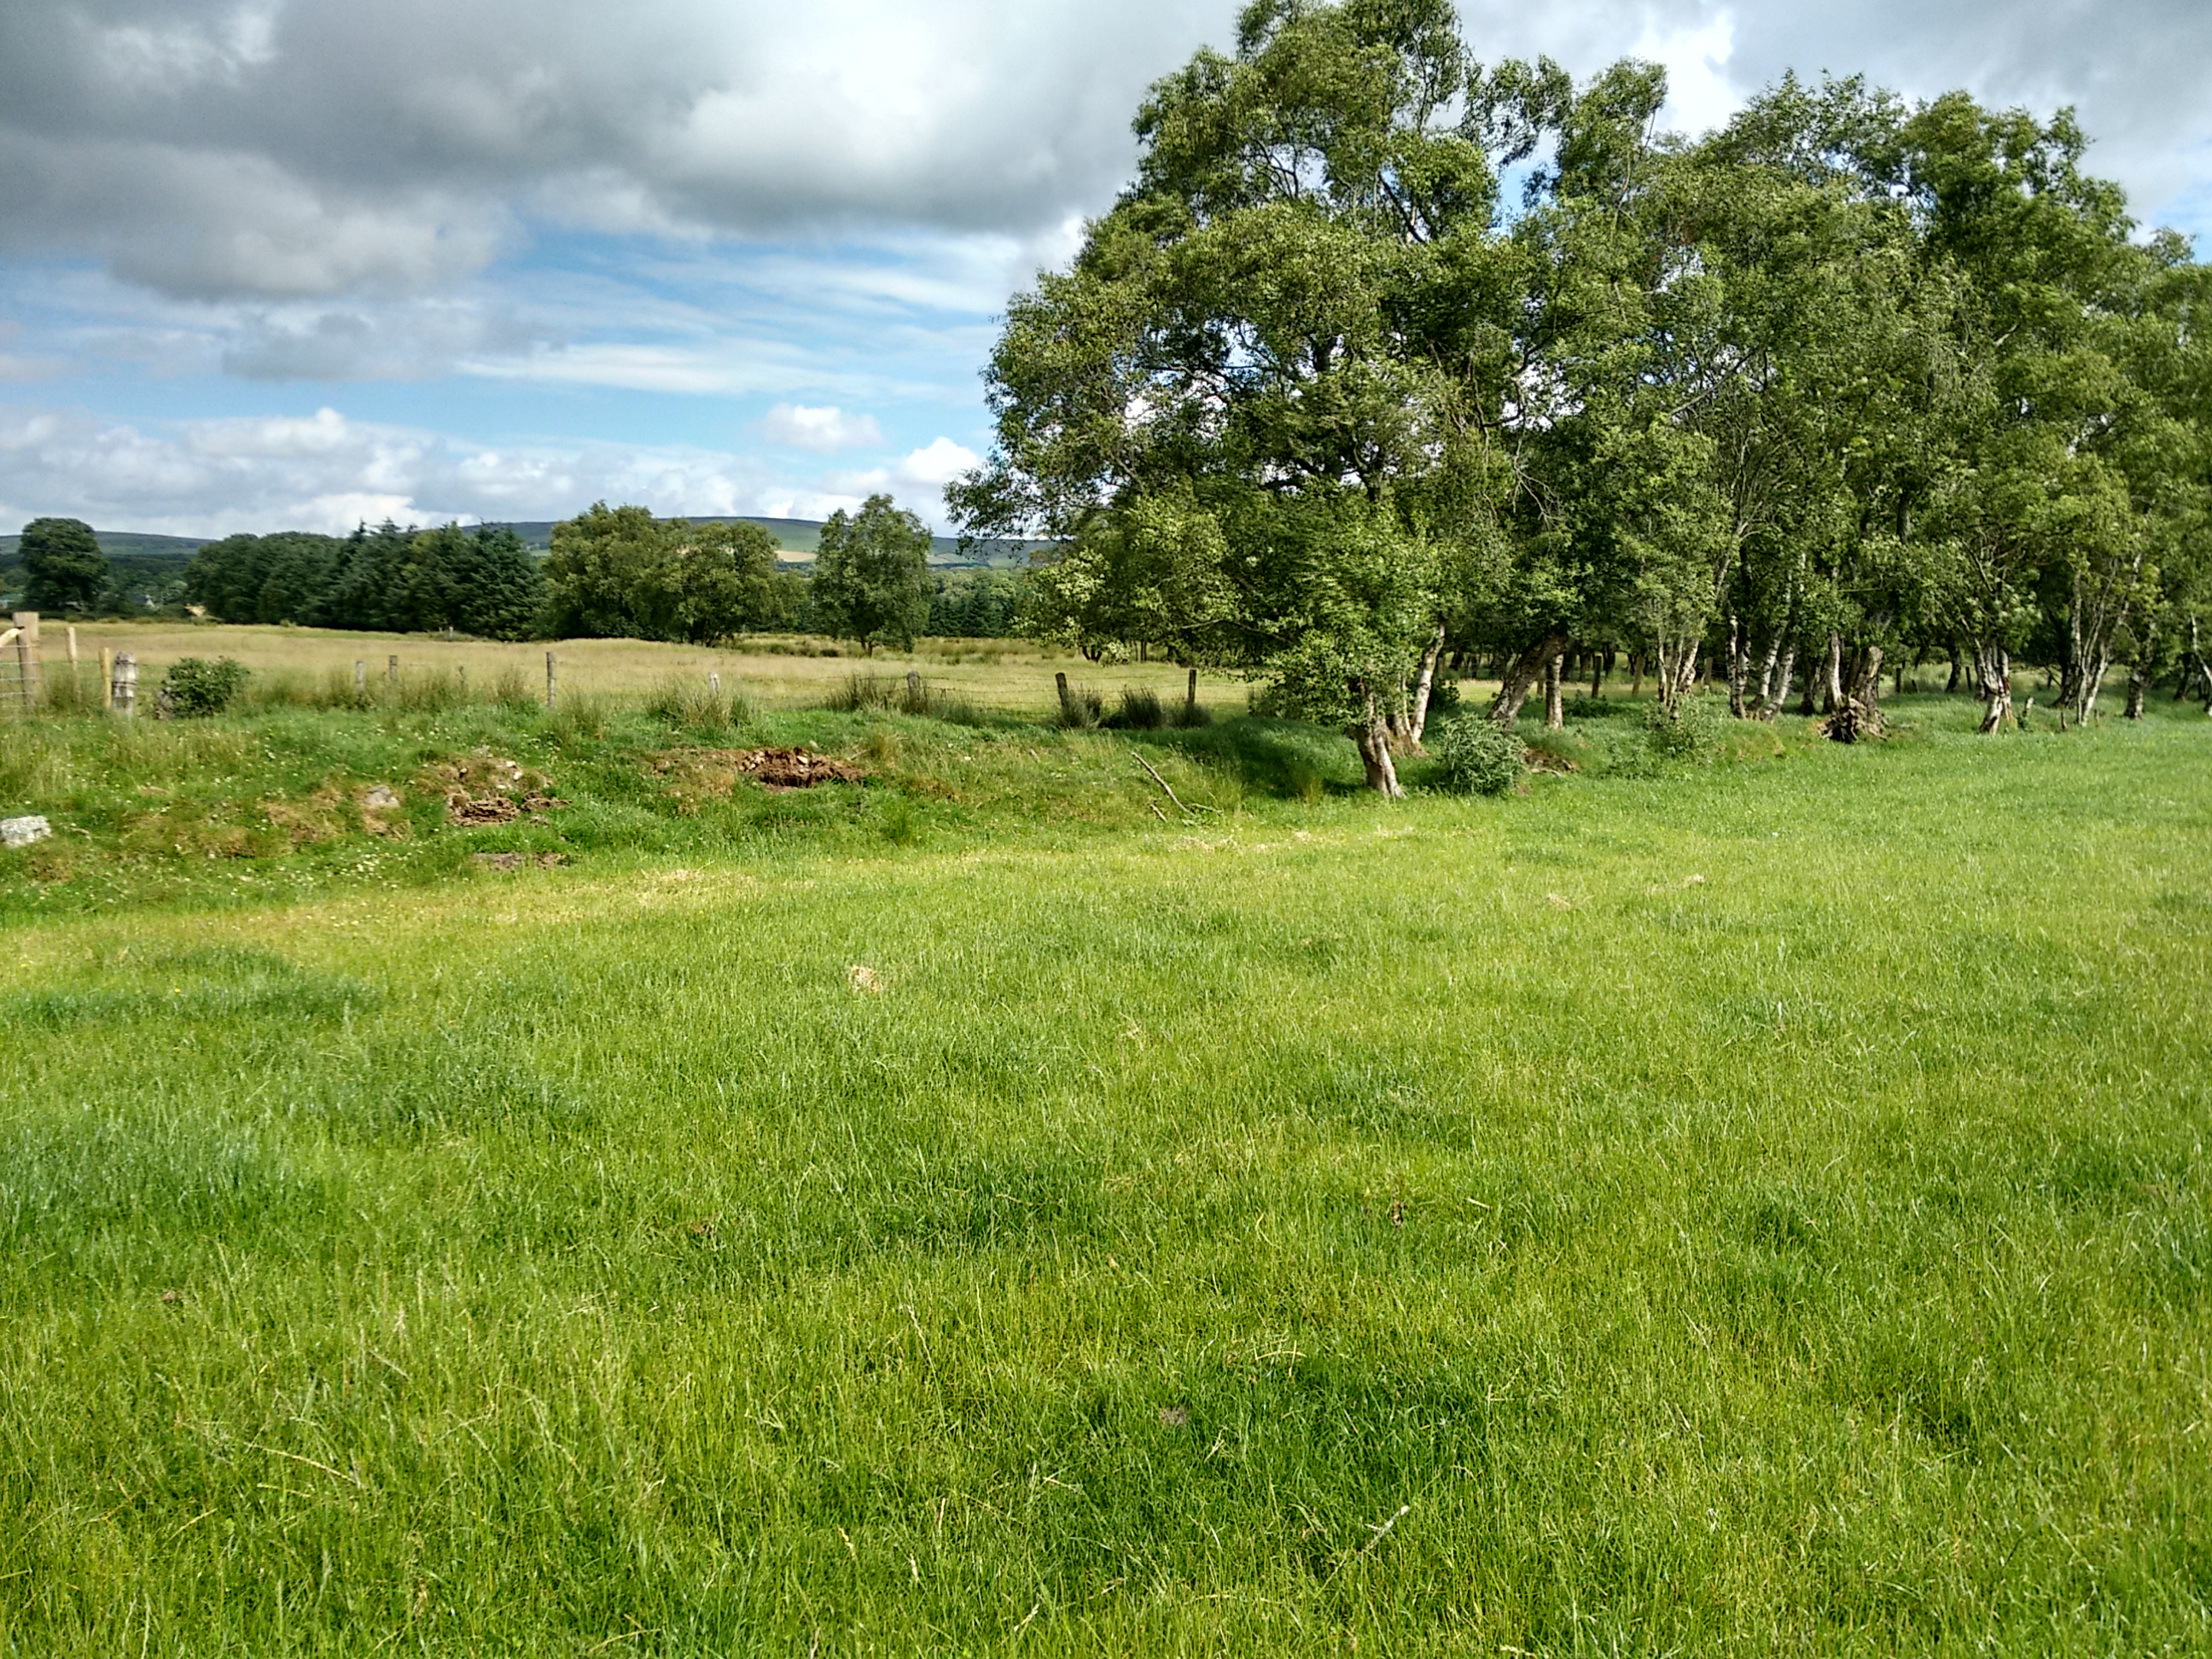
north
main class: Grassland
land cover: Grassland without tree/shrub cover
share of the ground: > 75 %
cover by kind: herbaceous plants 100 %
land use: Agriculture (excluding fallow land and kitchen gardens)
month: July
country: GB
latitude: 54.7169
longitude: -7.2061
